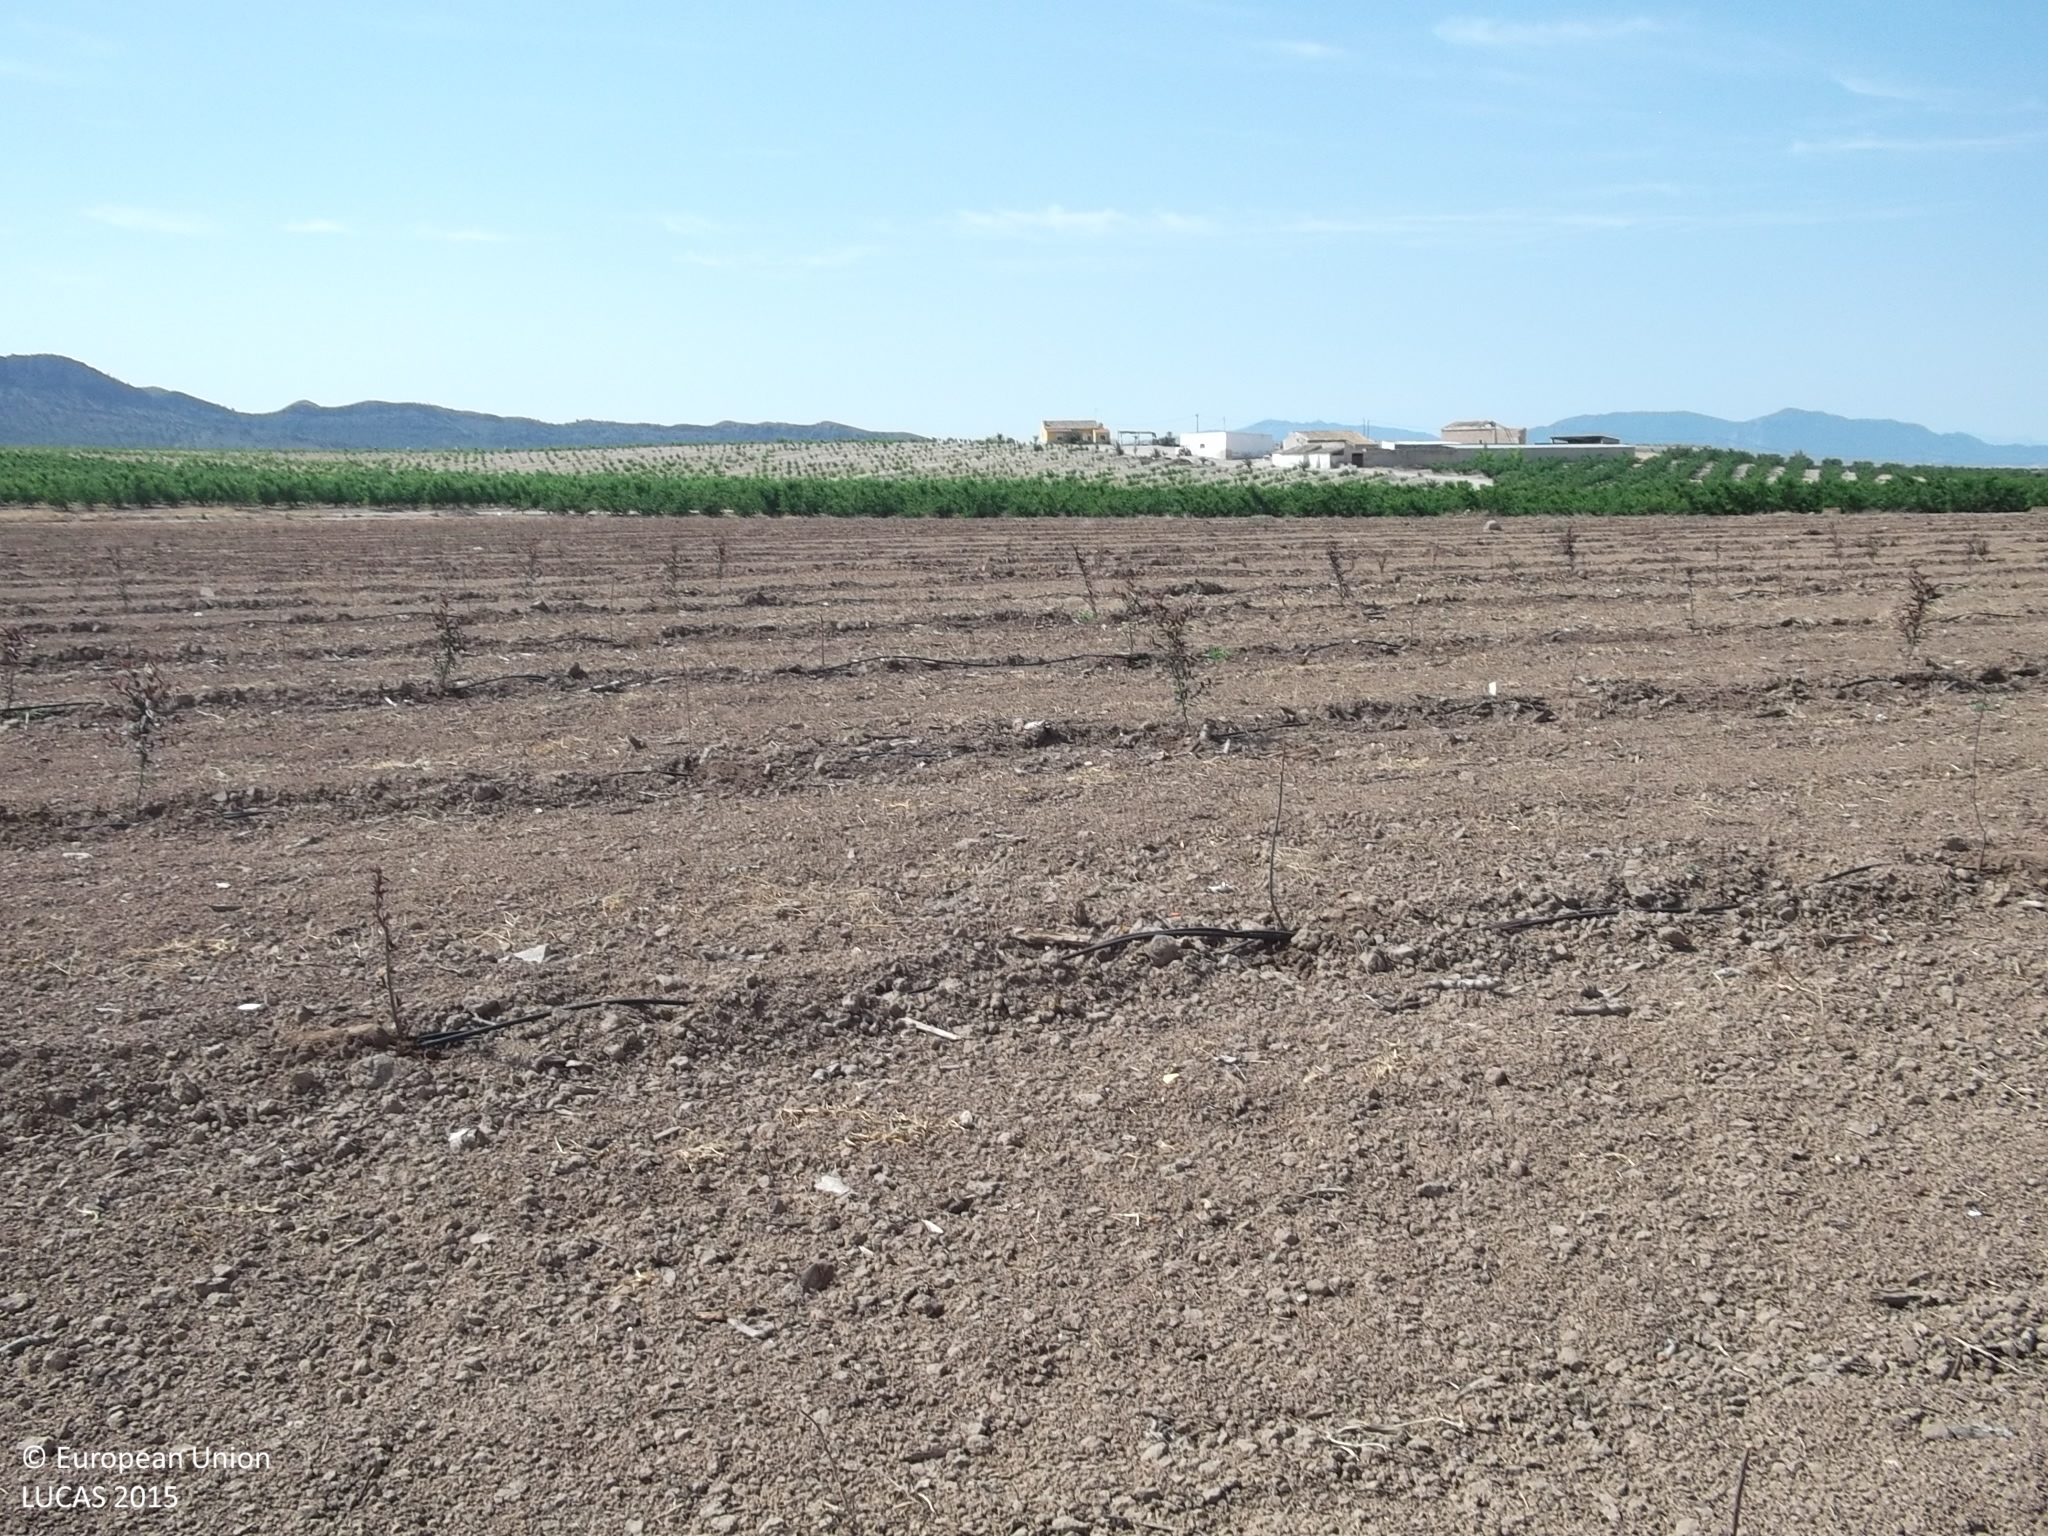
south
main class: Cropland
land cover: Other fruit trees and berries
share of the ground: < 10 %
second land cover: Other bare soil
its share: > 75 %
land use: Agriculture (excluding fallow land and kitchen gardens)
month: June
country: ES
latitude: 38.3736
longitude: -1.4250
